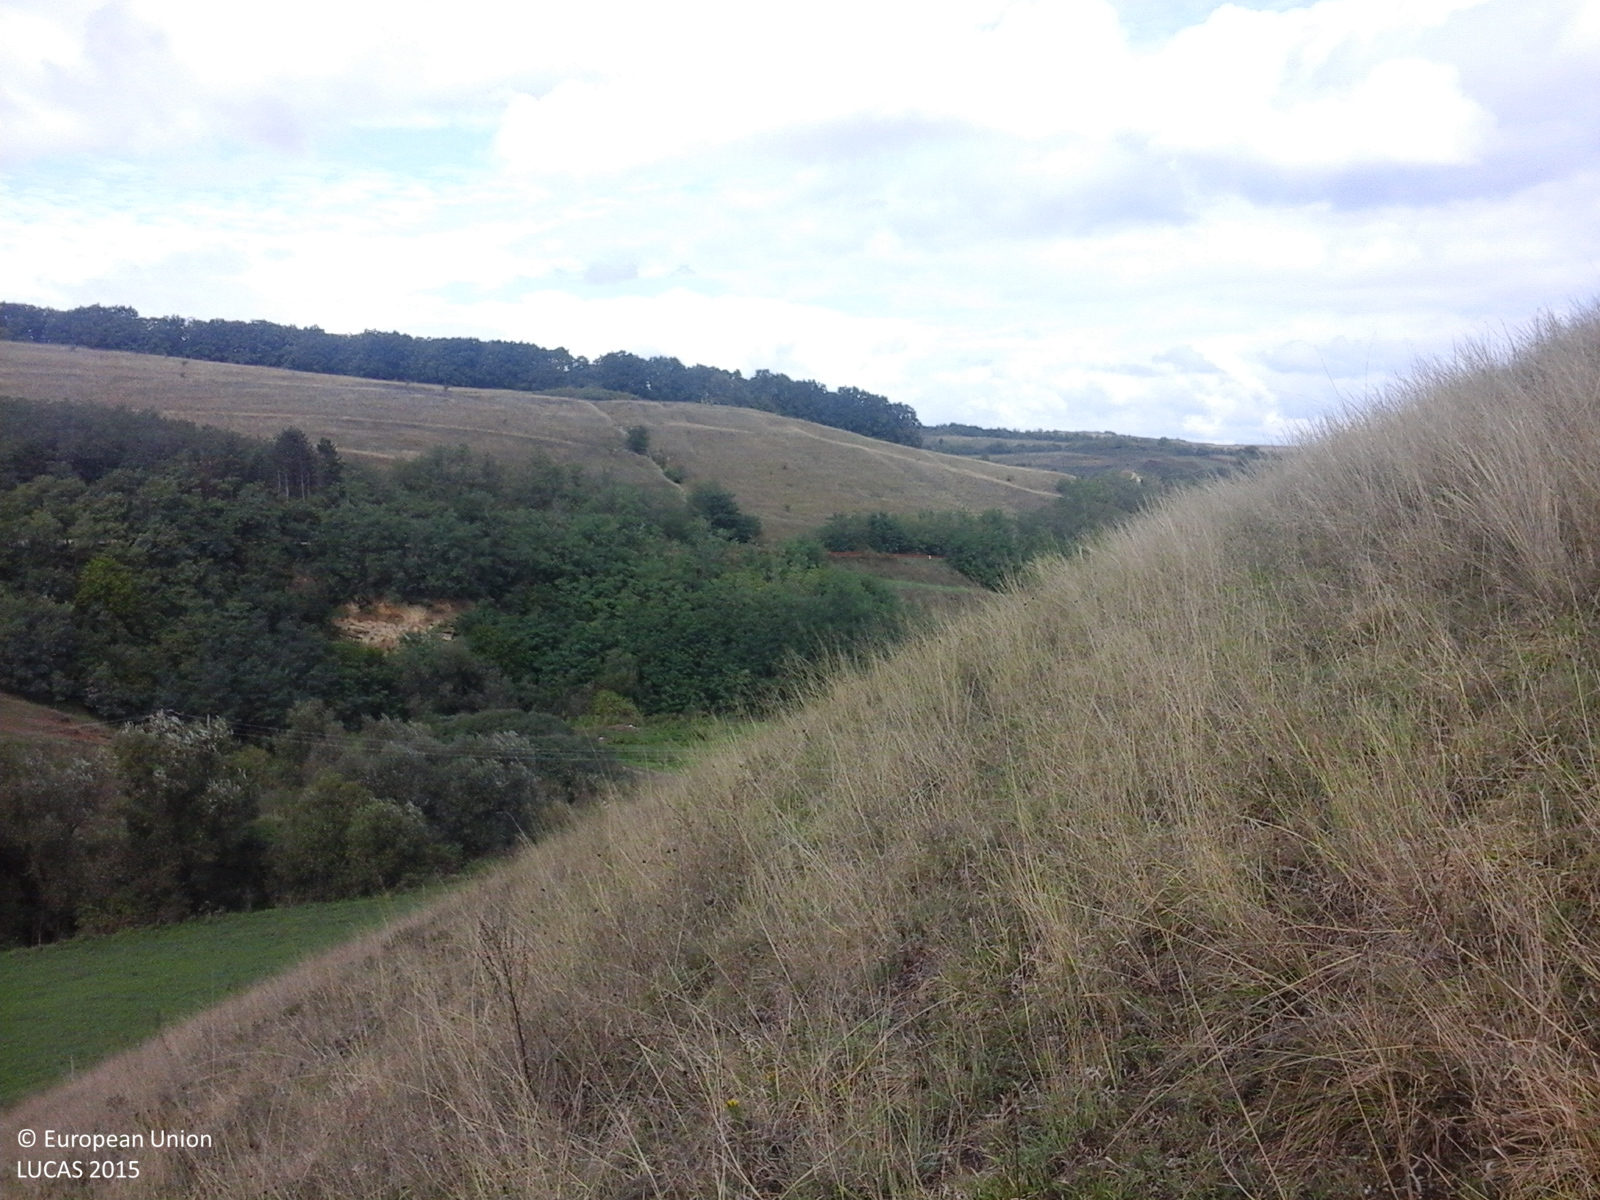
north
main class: Grassland
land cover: Grassland without tree/shrub cover
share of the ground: > 75 %
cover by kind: herbaceous plants 100 %
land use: Agriculture (excluding fallow land and kitchen gardens)
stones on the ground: < 10 %
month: September
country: RO
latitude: 46.0629
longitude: 23.7329
